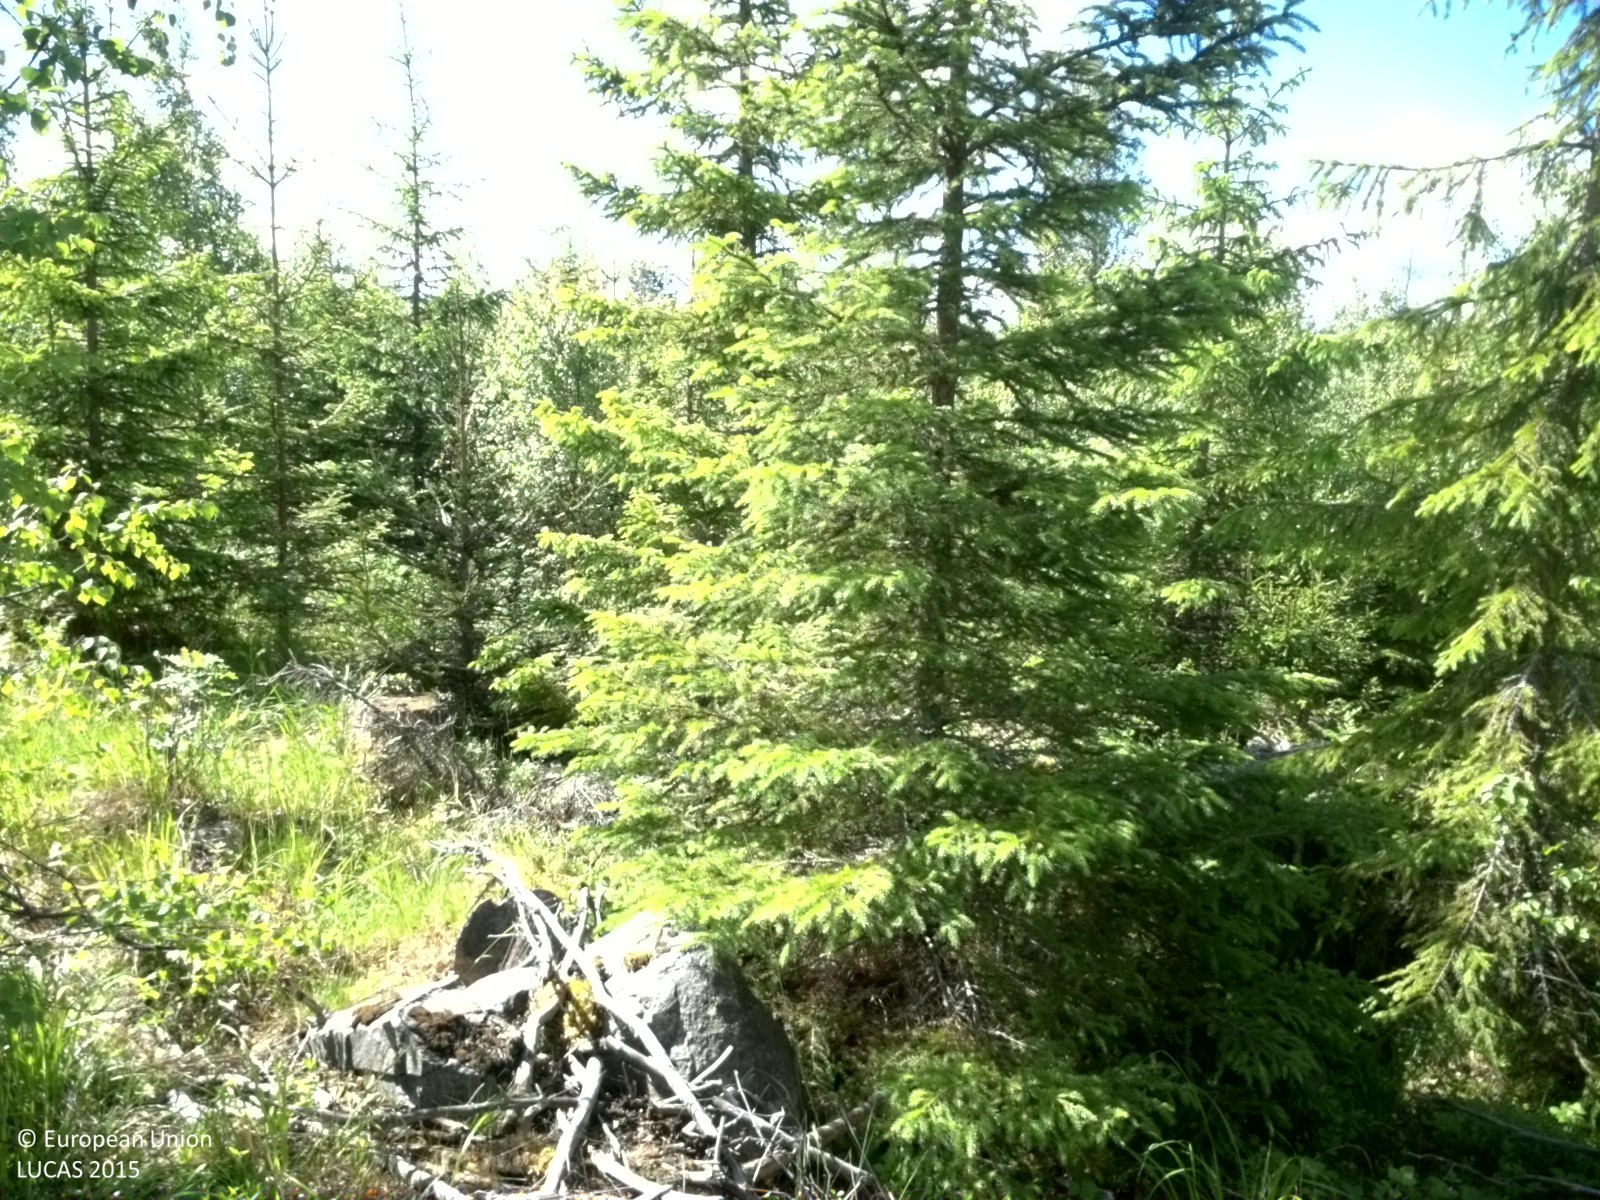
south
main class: Woodland
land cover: Spruce dominated mixed woodland
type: boreal forest
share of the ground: 50 - 75 %
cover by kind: broadleaved forest trees 30 %, coniferous forest trees 25 %, herbaceous plants 20 %, lichens and mosses 10 %, consolidated bare surface 10 %, shrubs 5 %
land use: Forestry
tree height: < 5 m
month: June
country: SE
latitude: 60.1500
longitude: 17.7204
